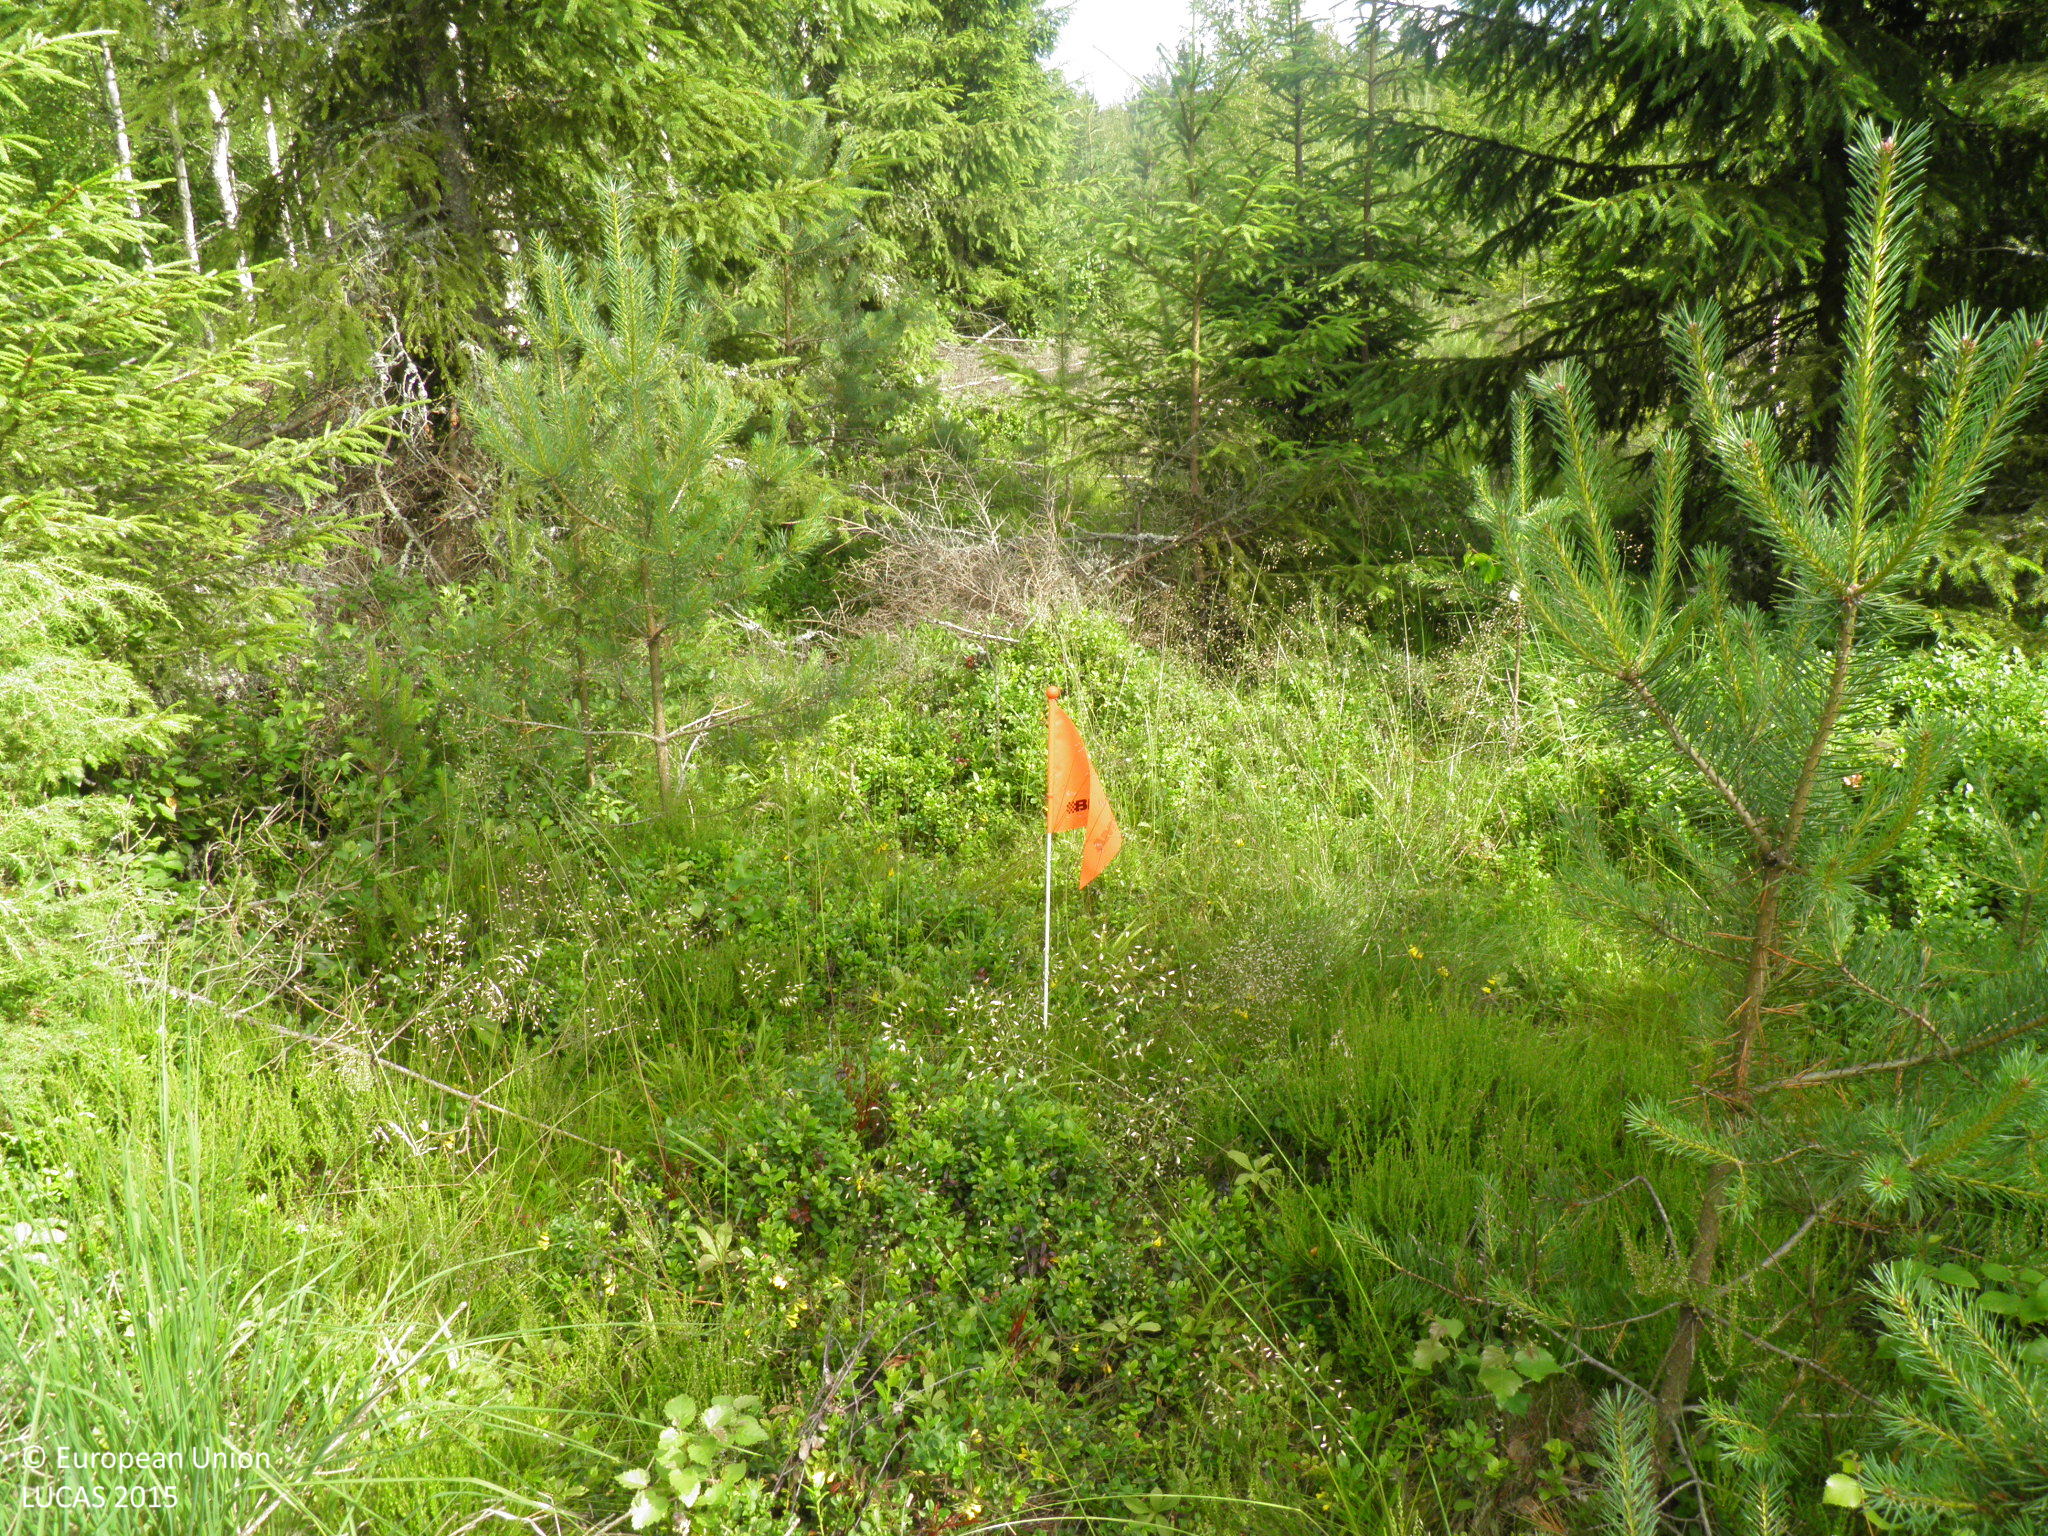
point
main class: Woodland
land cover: Spruce dominated mixed woodland
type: hemiboreal forest and nemoral coniferous forest and mixed broadleaved-coniferous forest
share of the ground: 25 - 50 %
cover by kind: shrubs 55 %, coniferous forest trees 20 %, broadleaved forest trees 20 %, herbaceous plants 5 %
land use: Forestry
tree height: > 5 m
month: July
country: FI
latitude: 60.7568
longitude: 22.6782
